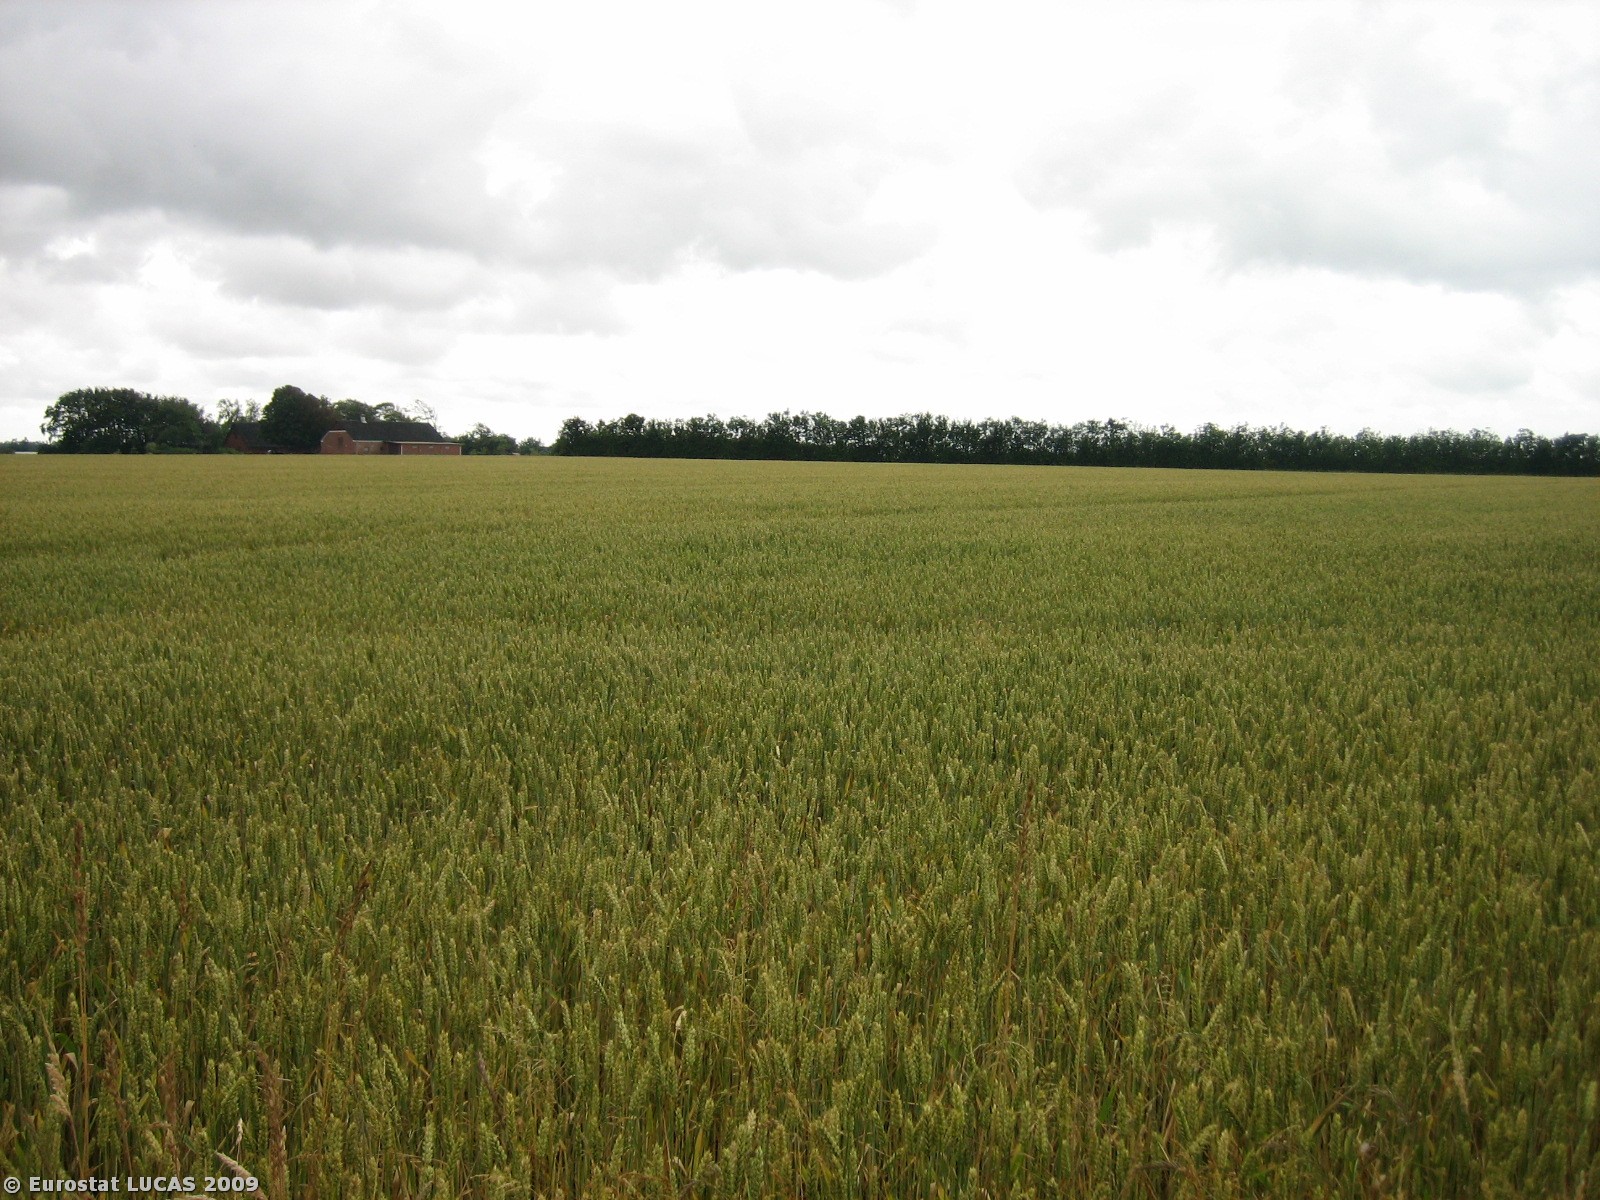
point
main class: Cropland
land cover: Common wheat
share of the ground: > 75 %
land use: Agriculture (excluding fallow land and kitchen gardens)
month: July
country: DK
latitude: 55.6380
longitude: 8.3652
